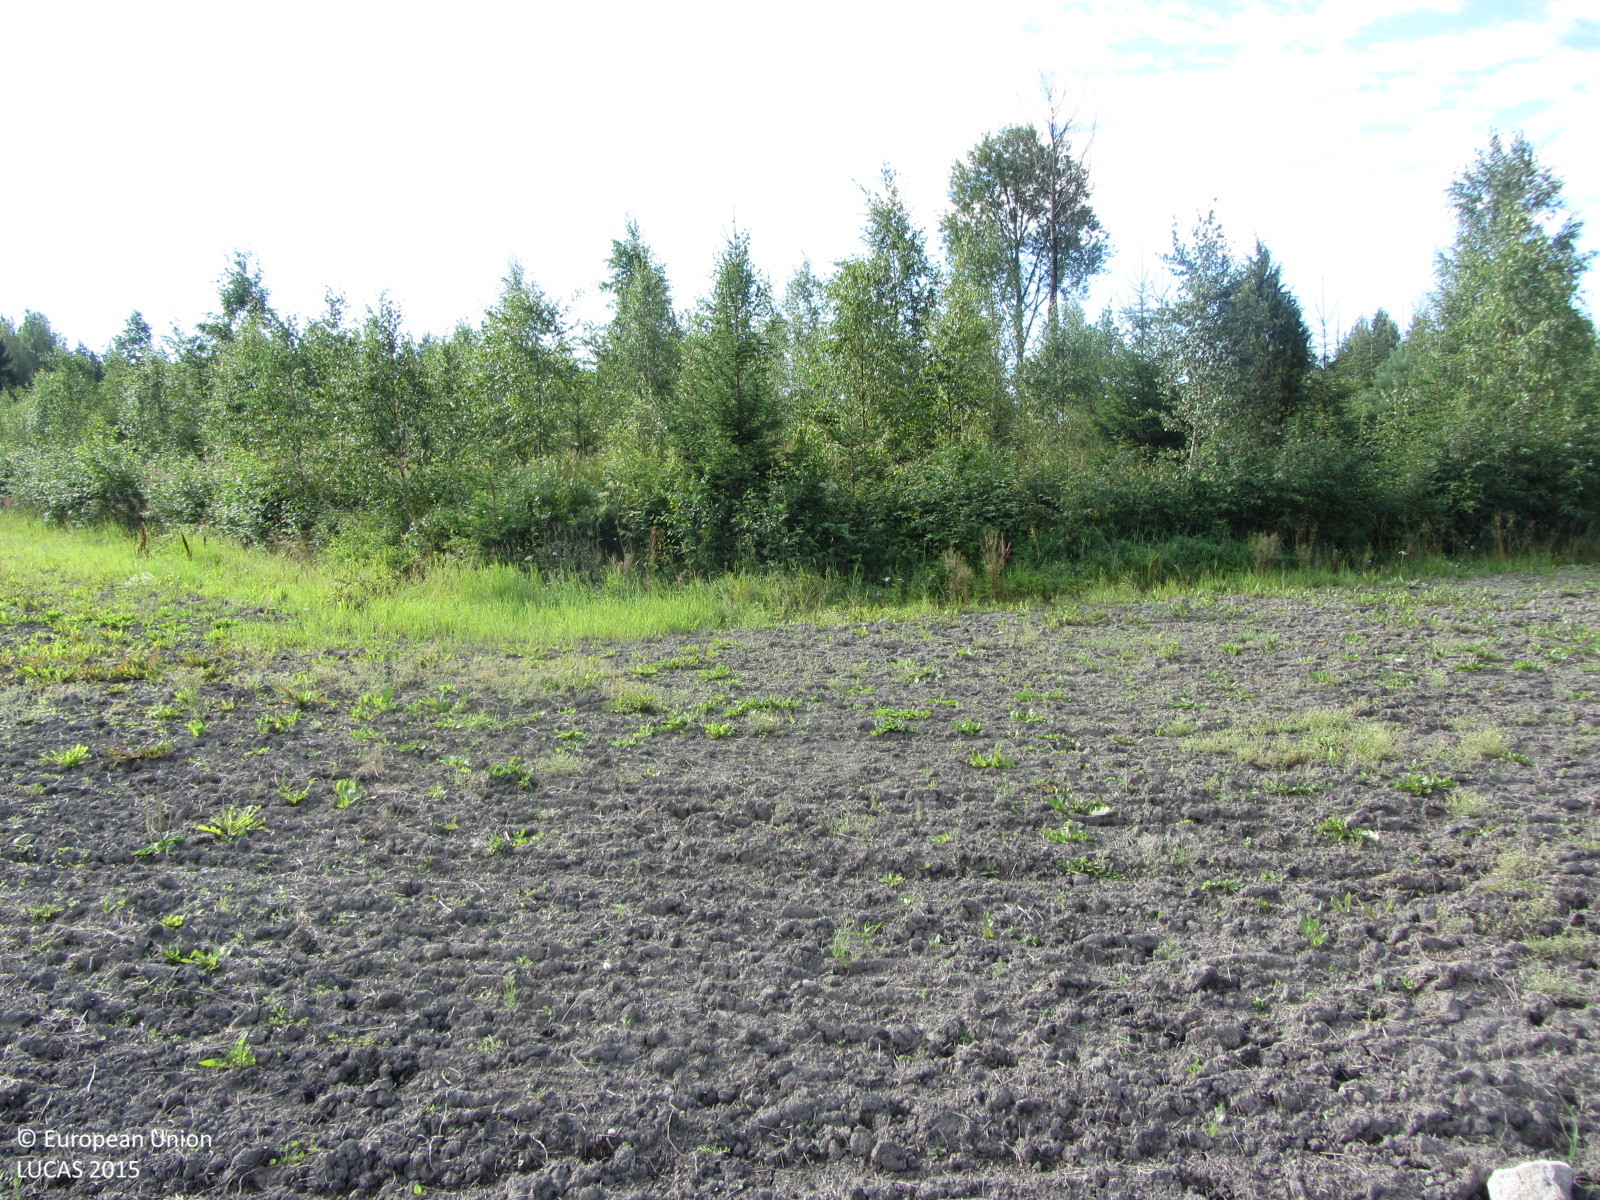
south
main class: Grassland
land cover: Spontaneously vegetated surfaces
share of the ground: 25 - 50 %
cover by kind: unconsolidated bare surface 65 %, herbaceous plants 35 %
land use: Fallow land
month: August
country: FI
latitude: 60.4129
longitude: 23.4313
